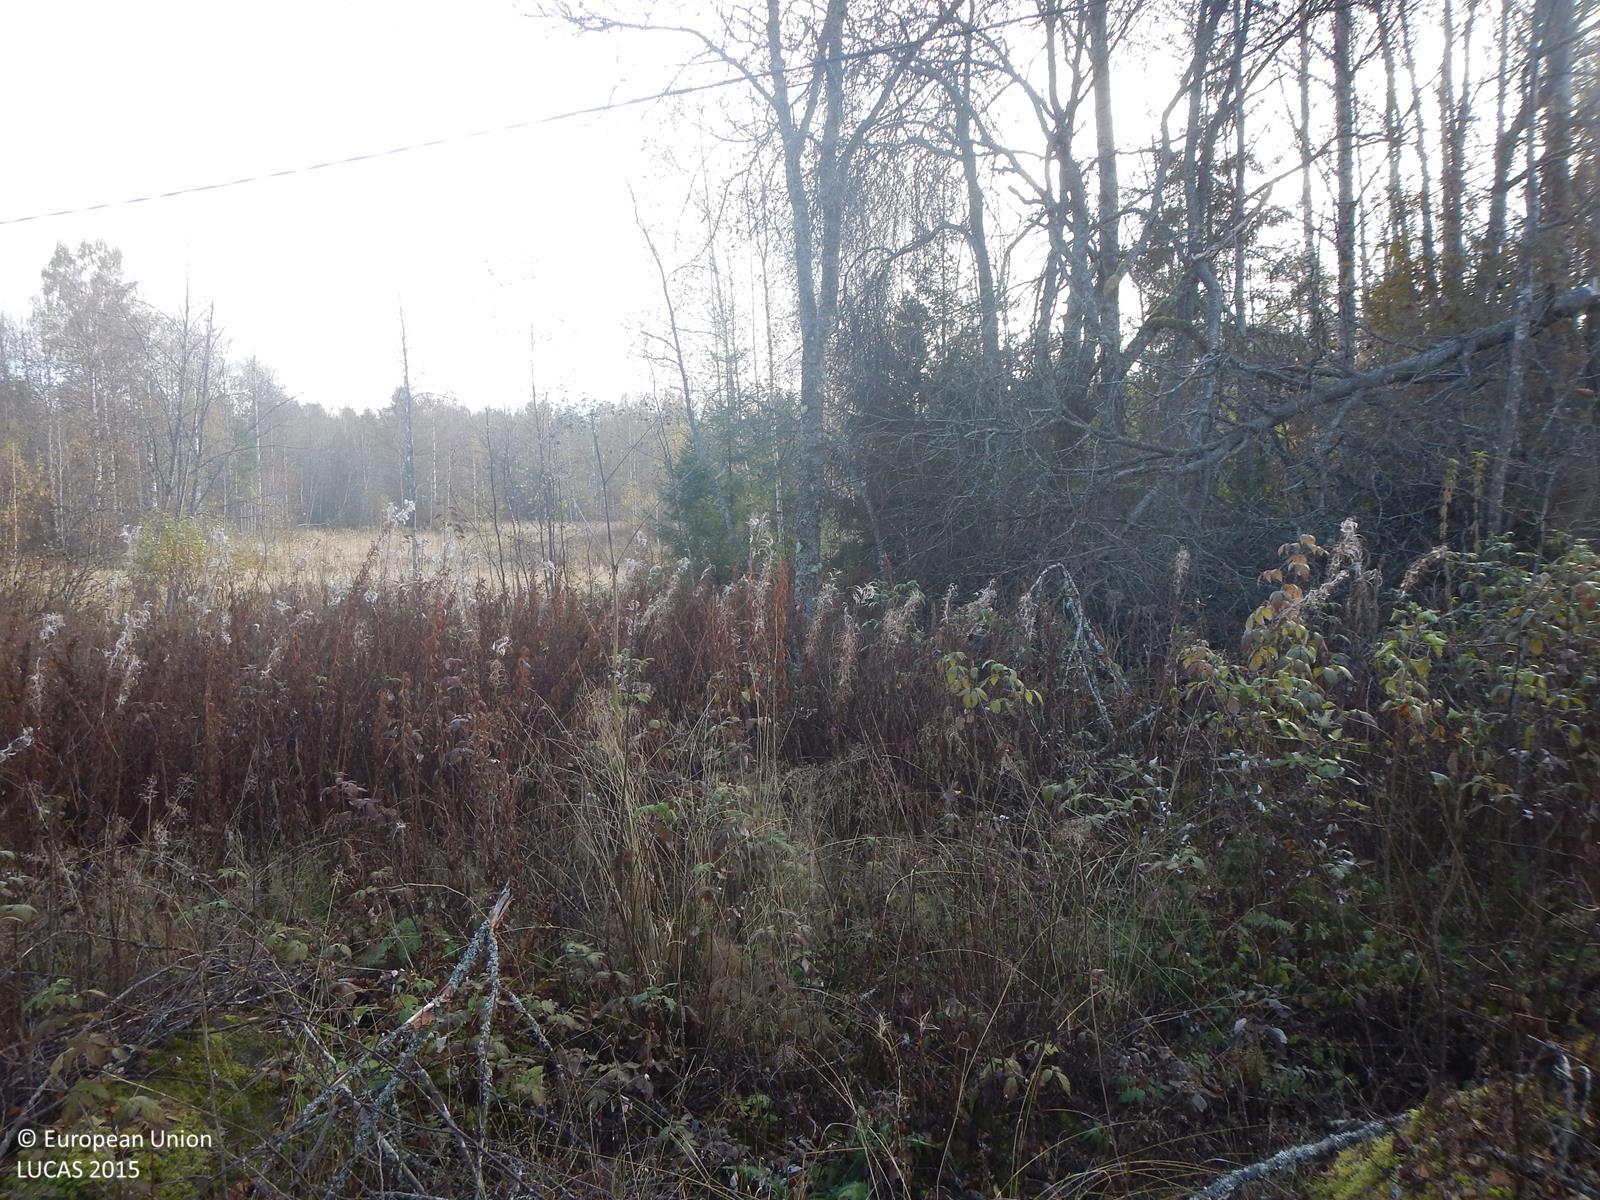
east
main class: Woodland
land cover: Broadleaved woodland
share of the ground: 25 - 50 %
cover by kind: broadleaved forest trees 40 %, herbaceous plants 20 %, shrubs 10 %, lichens and mosses 10 %, consolidated bare surface 10 %
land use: Forestry
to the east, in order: Broadleaved woodland; Spontaneously vegetated surfaces; Electric lines; Spontaneously vegetated surfaces; Electric lines; Spontaneously vegetated surfaces; Ditches and canals; Spontaneously vegetated surfaces; Broadleaved woodland; Ditches and canals; Broadleaved woodland; Spontaneously vegetated surfaces; Grassland without tree/shrub cover; Spontaneously vegetated surfaces; Broadleaved woodland; Artificial constructions in urban areas; Spontaneously vegetated surfaces; Ditches and canals; Spontaneously vegetated surfaces; Broadleaved woodland; Tracks; Broadleaved woodland; Spontaneously vegetated surfaces; Broadleaved woodland; Other mixed woodland
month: October
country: FI
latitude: 61.6317
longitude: 25.8831
